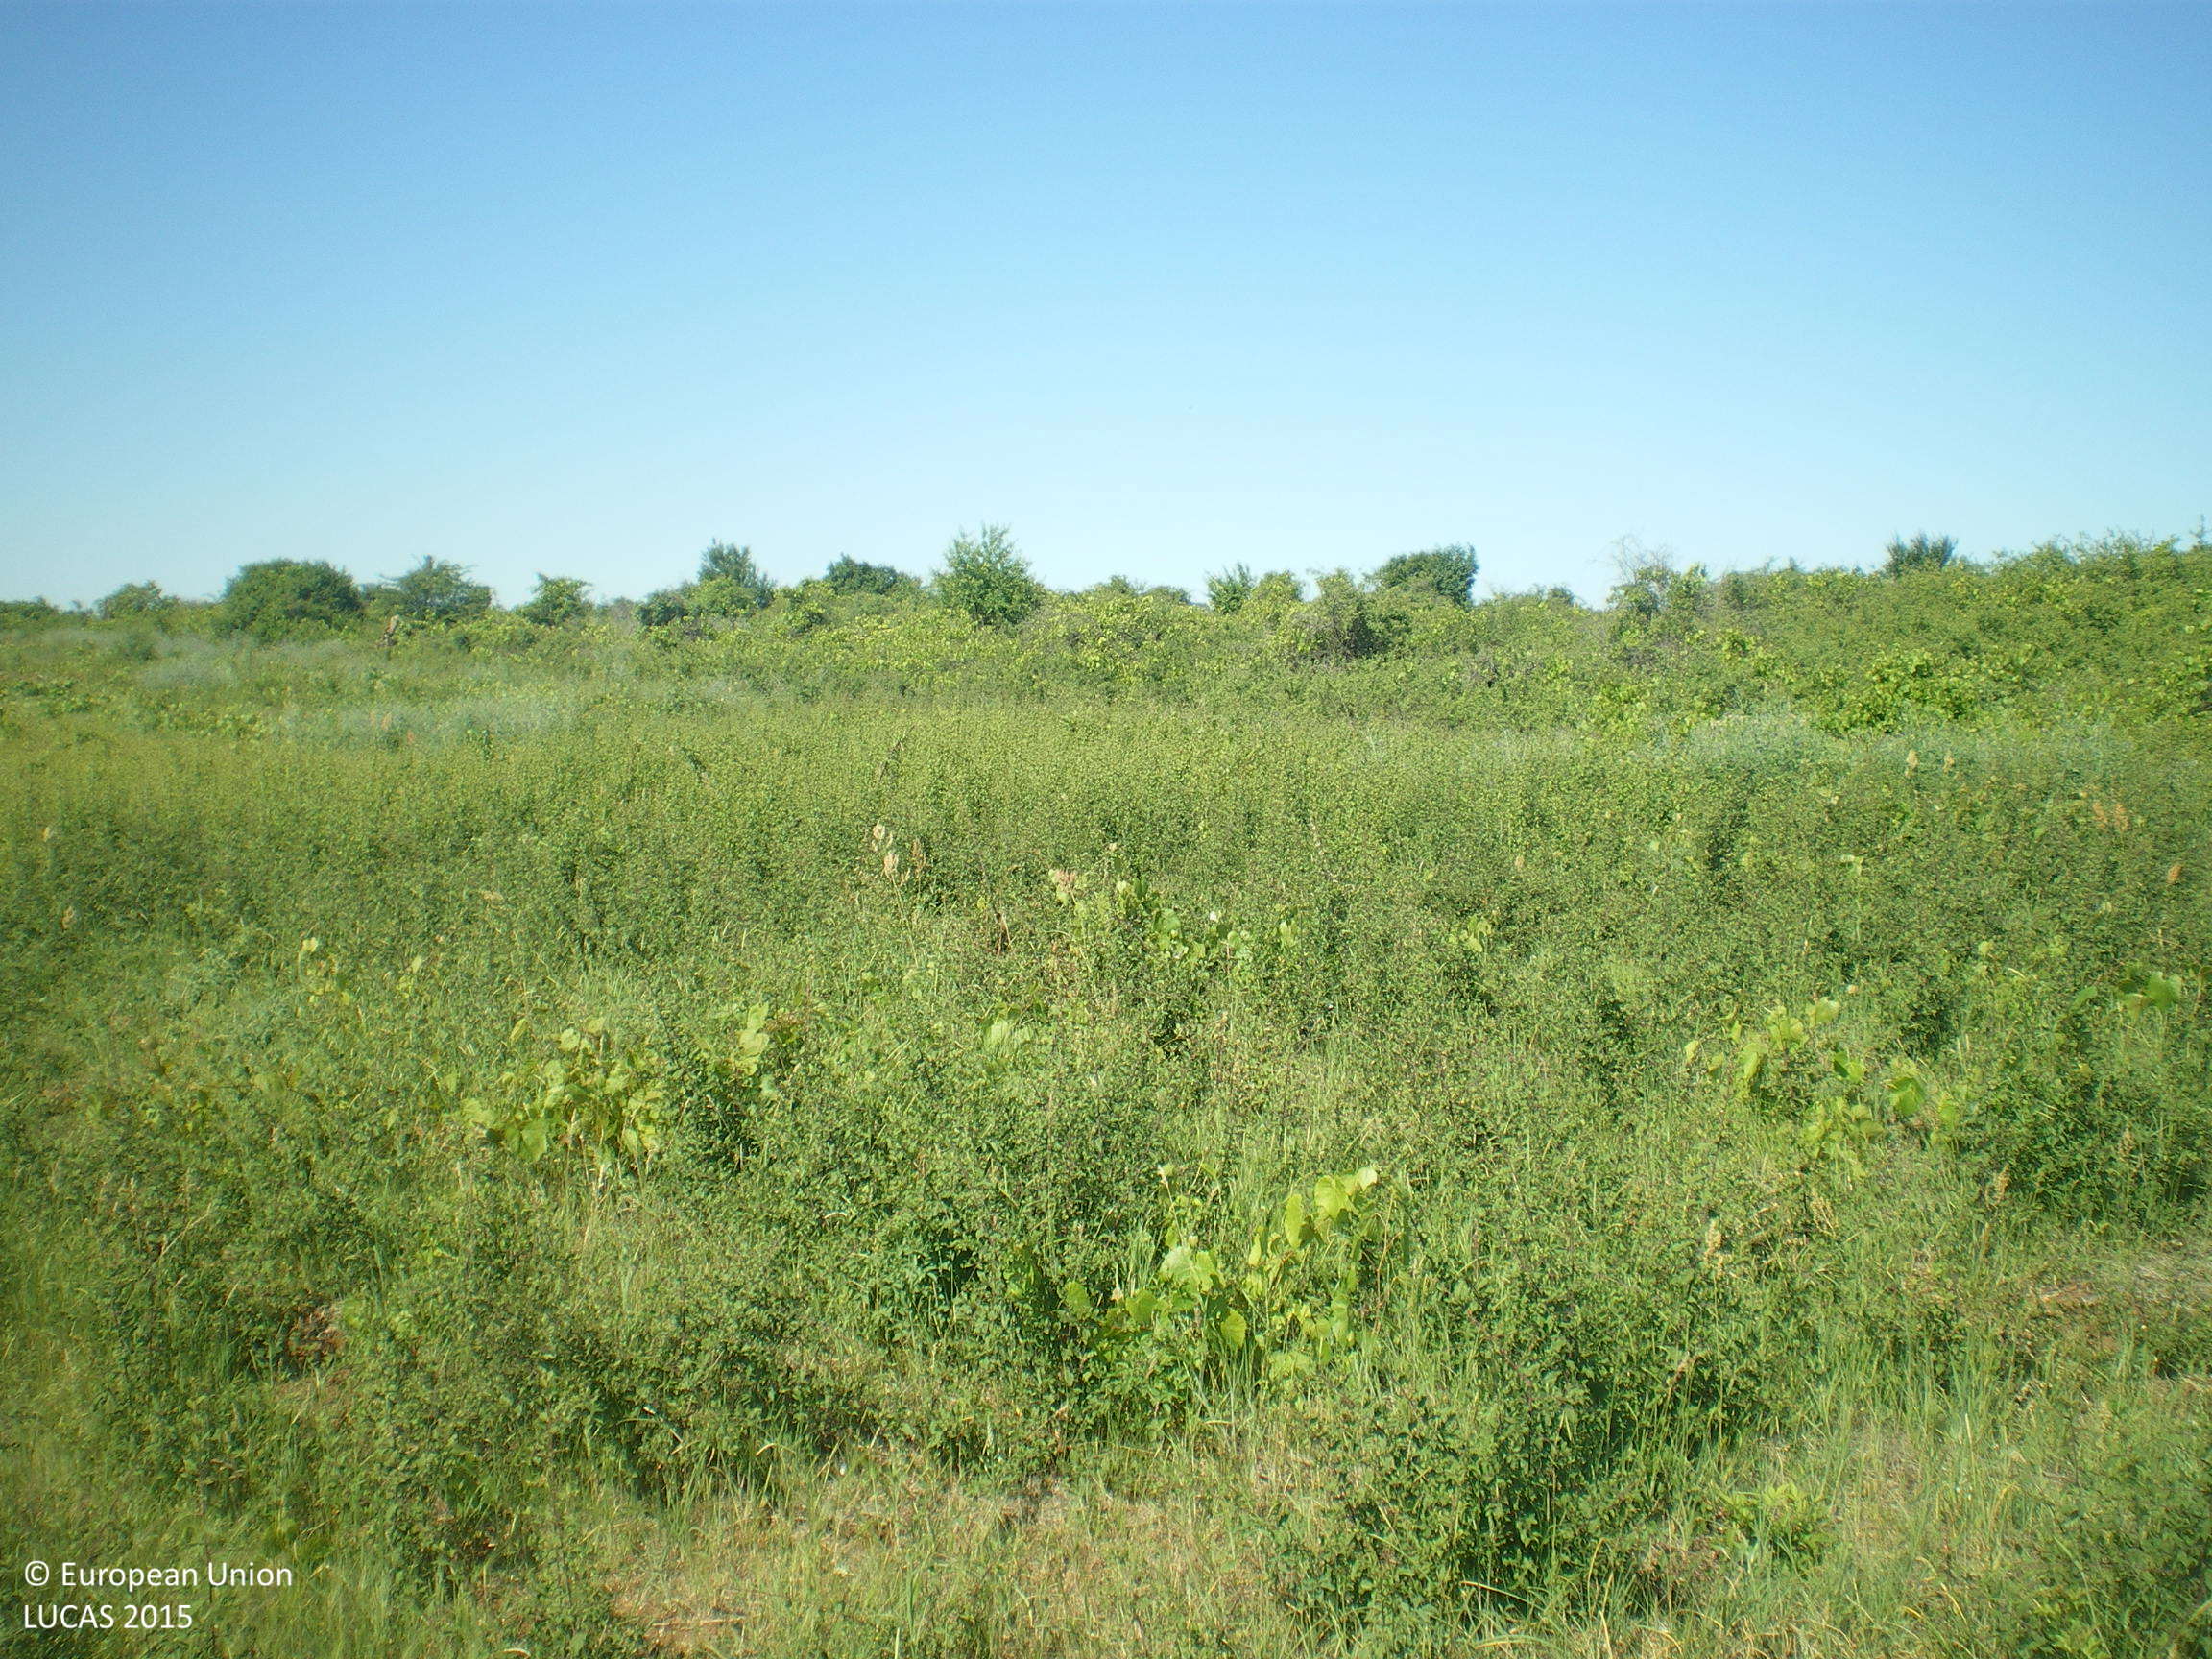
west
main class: Cropland
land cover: Vineyards
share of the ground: 10 - 25 %
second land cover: Shrubland without tree cover
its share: 50 - 75 %
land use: Abandoned areas
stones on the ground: < 10 %
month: June
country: BG
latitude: 42.3029
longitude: 25.4605
